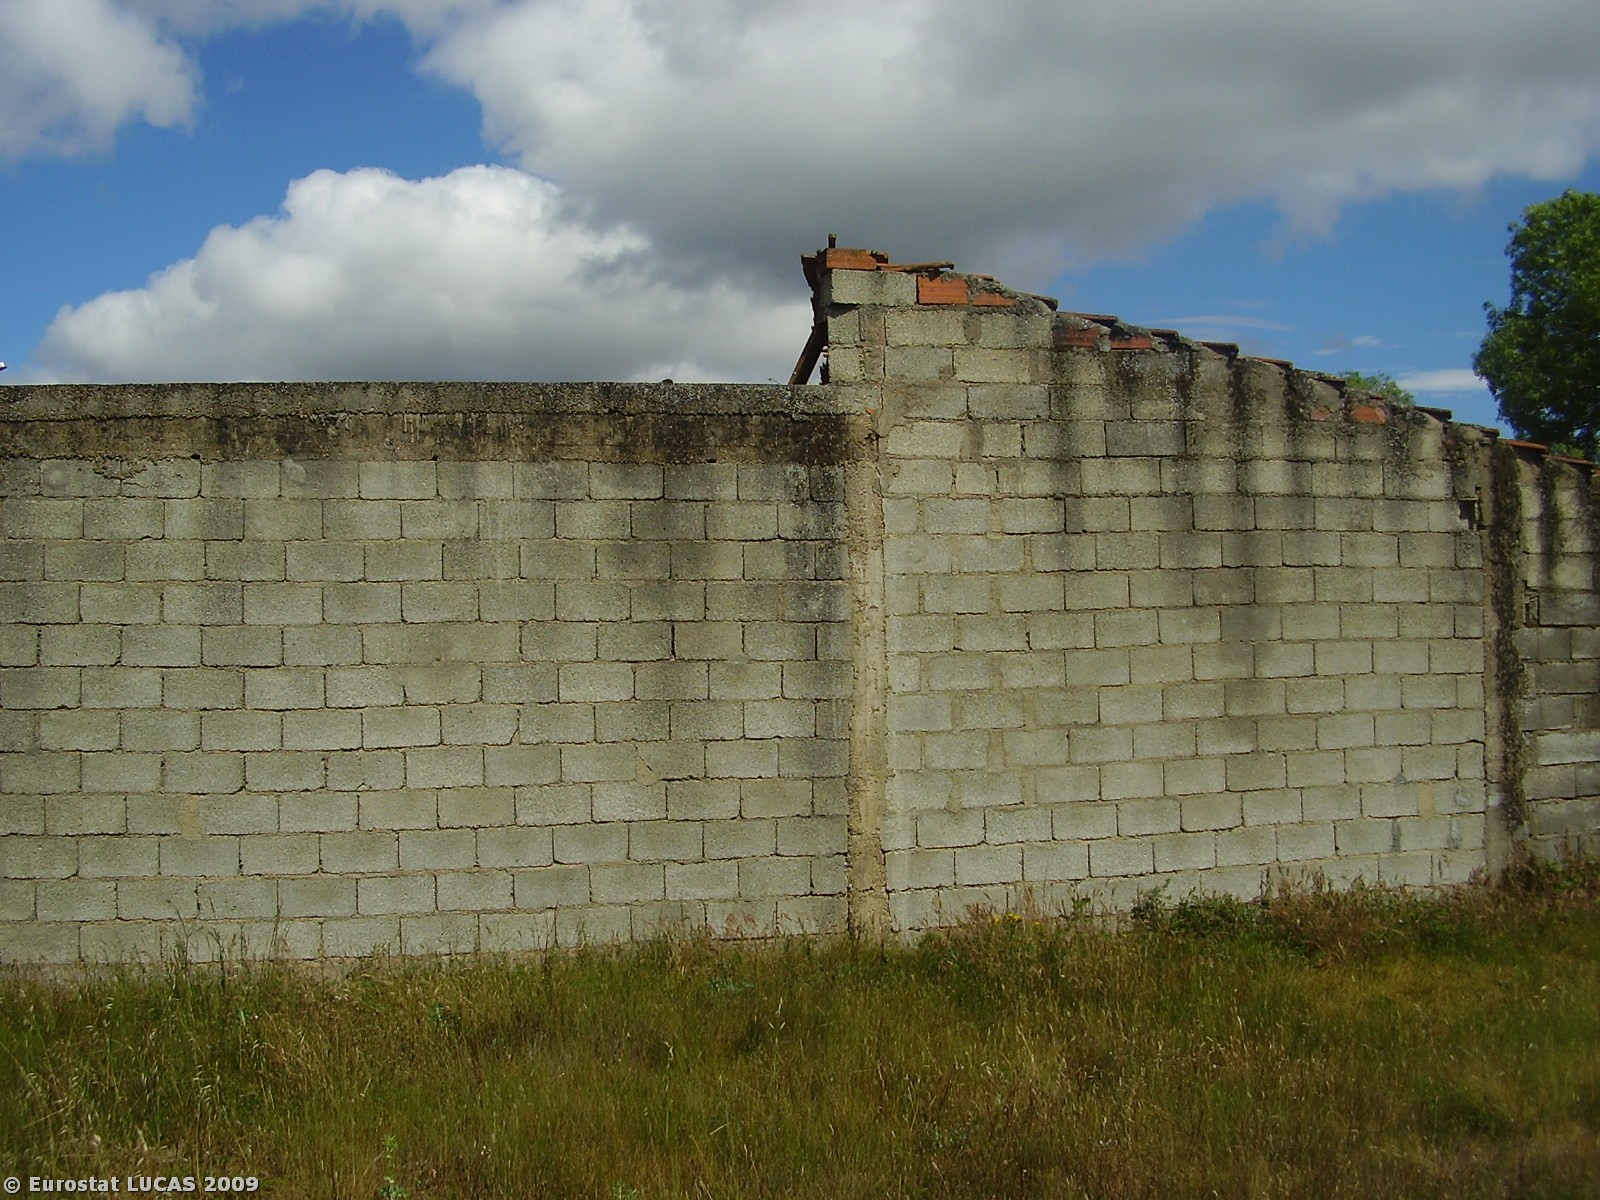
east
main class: Cropland
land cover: Temporary grasslands
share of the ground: > 75 %
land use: Agriculture (excluding fallow land and kitchen gardens)
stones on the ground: 10 - 25 %
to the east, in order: Temporary grasslands; Artificial constructions in urban areas; Grass margins; Paved roads, cycling and walking lanes; Grass margins; Ditches and canals; Artificial constructions; Oats; Spontaneously vegetated surfaces; Single bushes/trees; Spontaneously vegetated surfaces; Artificial constructions in urban areas; Fences; Spontaneously vegetated surfaces; Abandoned hedges; Dry stone walls; Abandoned hedges; Ditches and canals; Mixed cereals for fodder
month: June
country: PT
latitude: 41.5245
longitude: -6.8530
